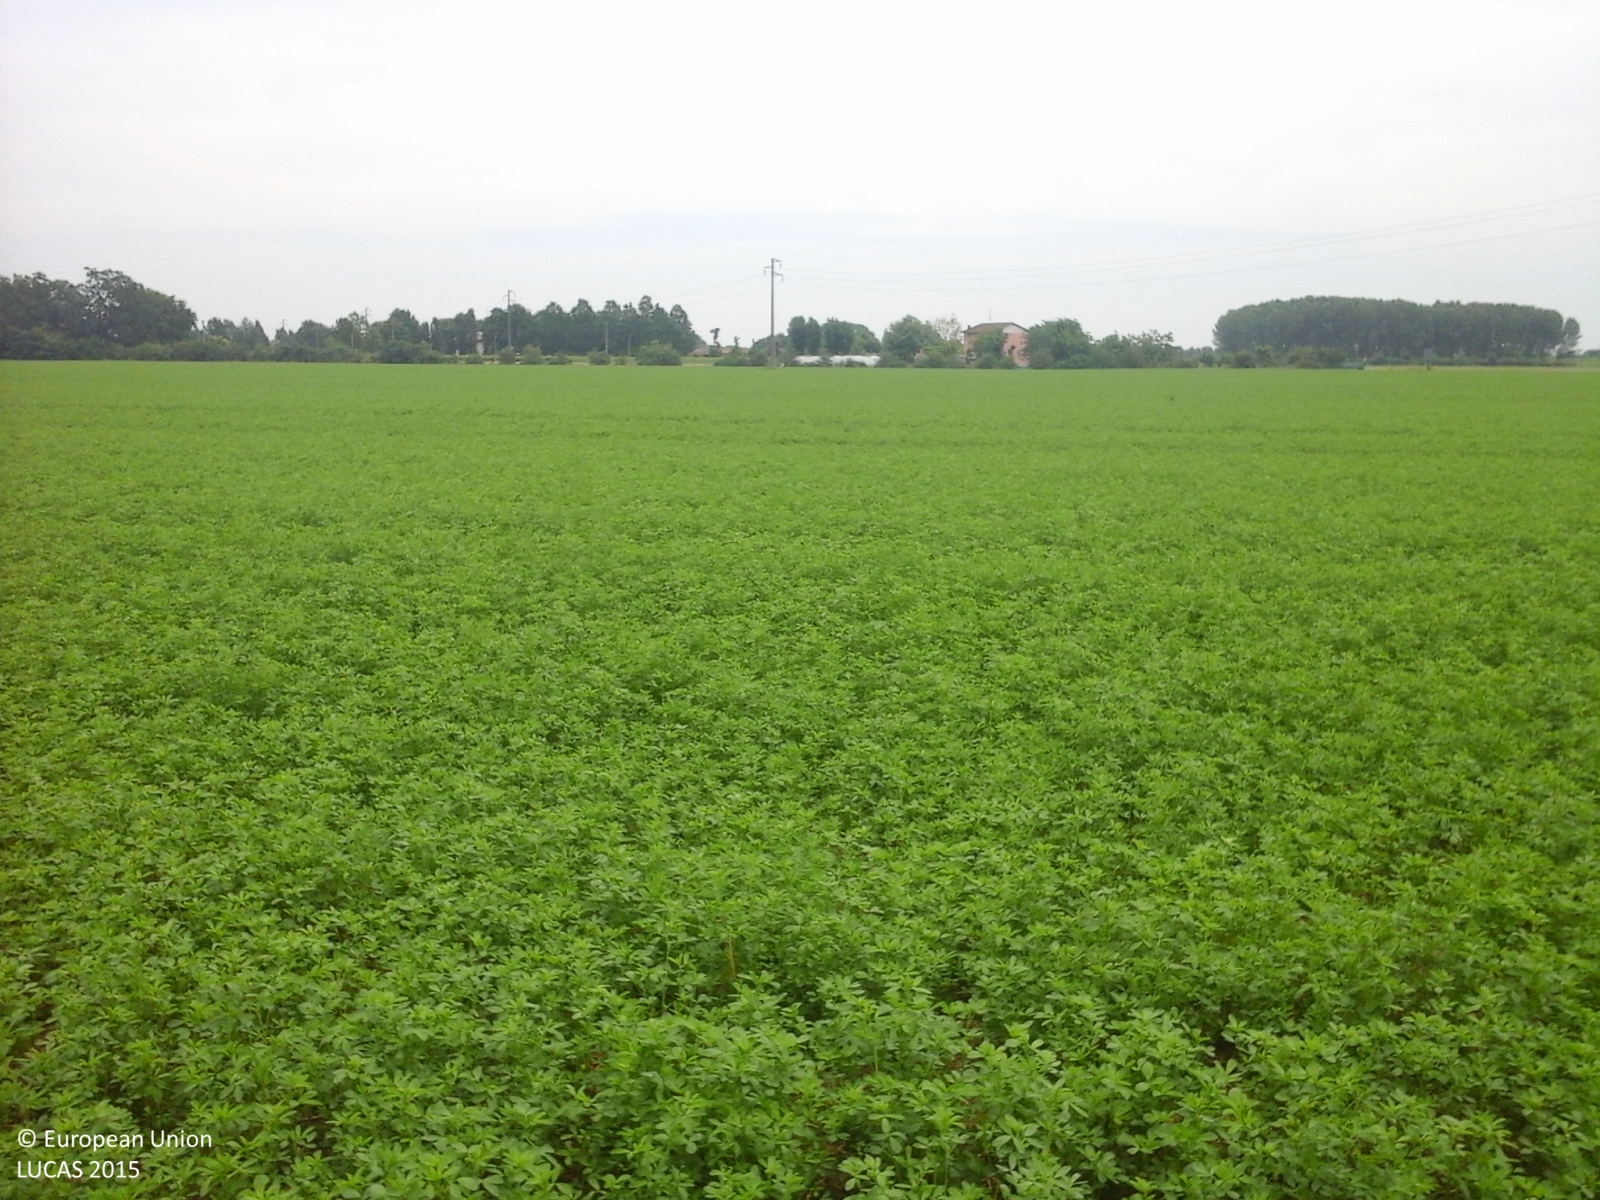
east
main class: Cropland
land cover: Lucerne
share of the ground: > 75 %
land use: Agriculture (excluding fallow land and kitchen gardens)
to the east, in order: Lucerne; Ditches and canals; Lucerne; Ditches and canals; Lucerne; Ditches and canals; Lucerne; Ditches and canals; Lucerne; Ditches and canals; Lucerne; Ditches and canals; Lucerne; Ditches and canals; Lucerne; Ditches and canals; Lucerne
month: June
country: IT
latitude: 44.6151
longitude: 11.1192
